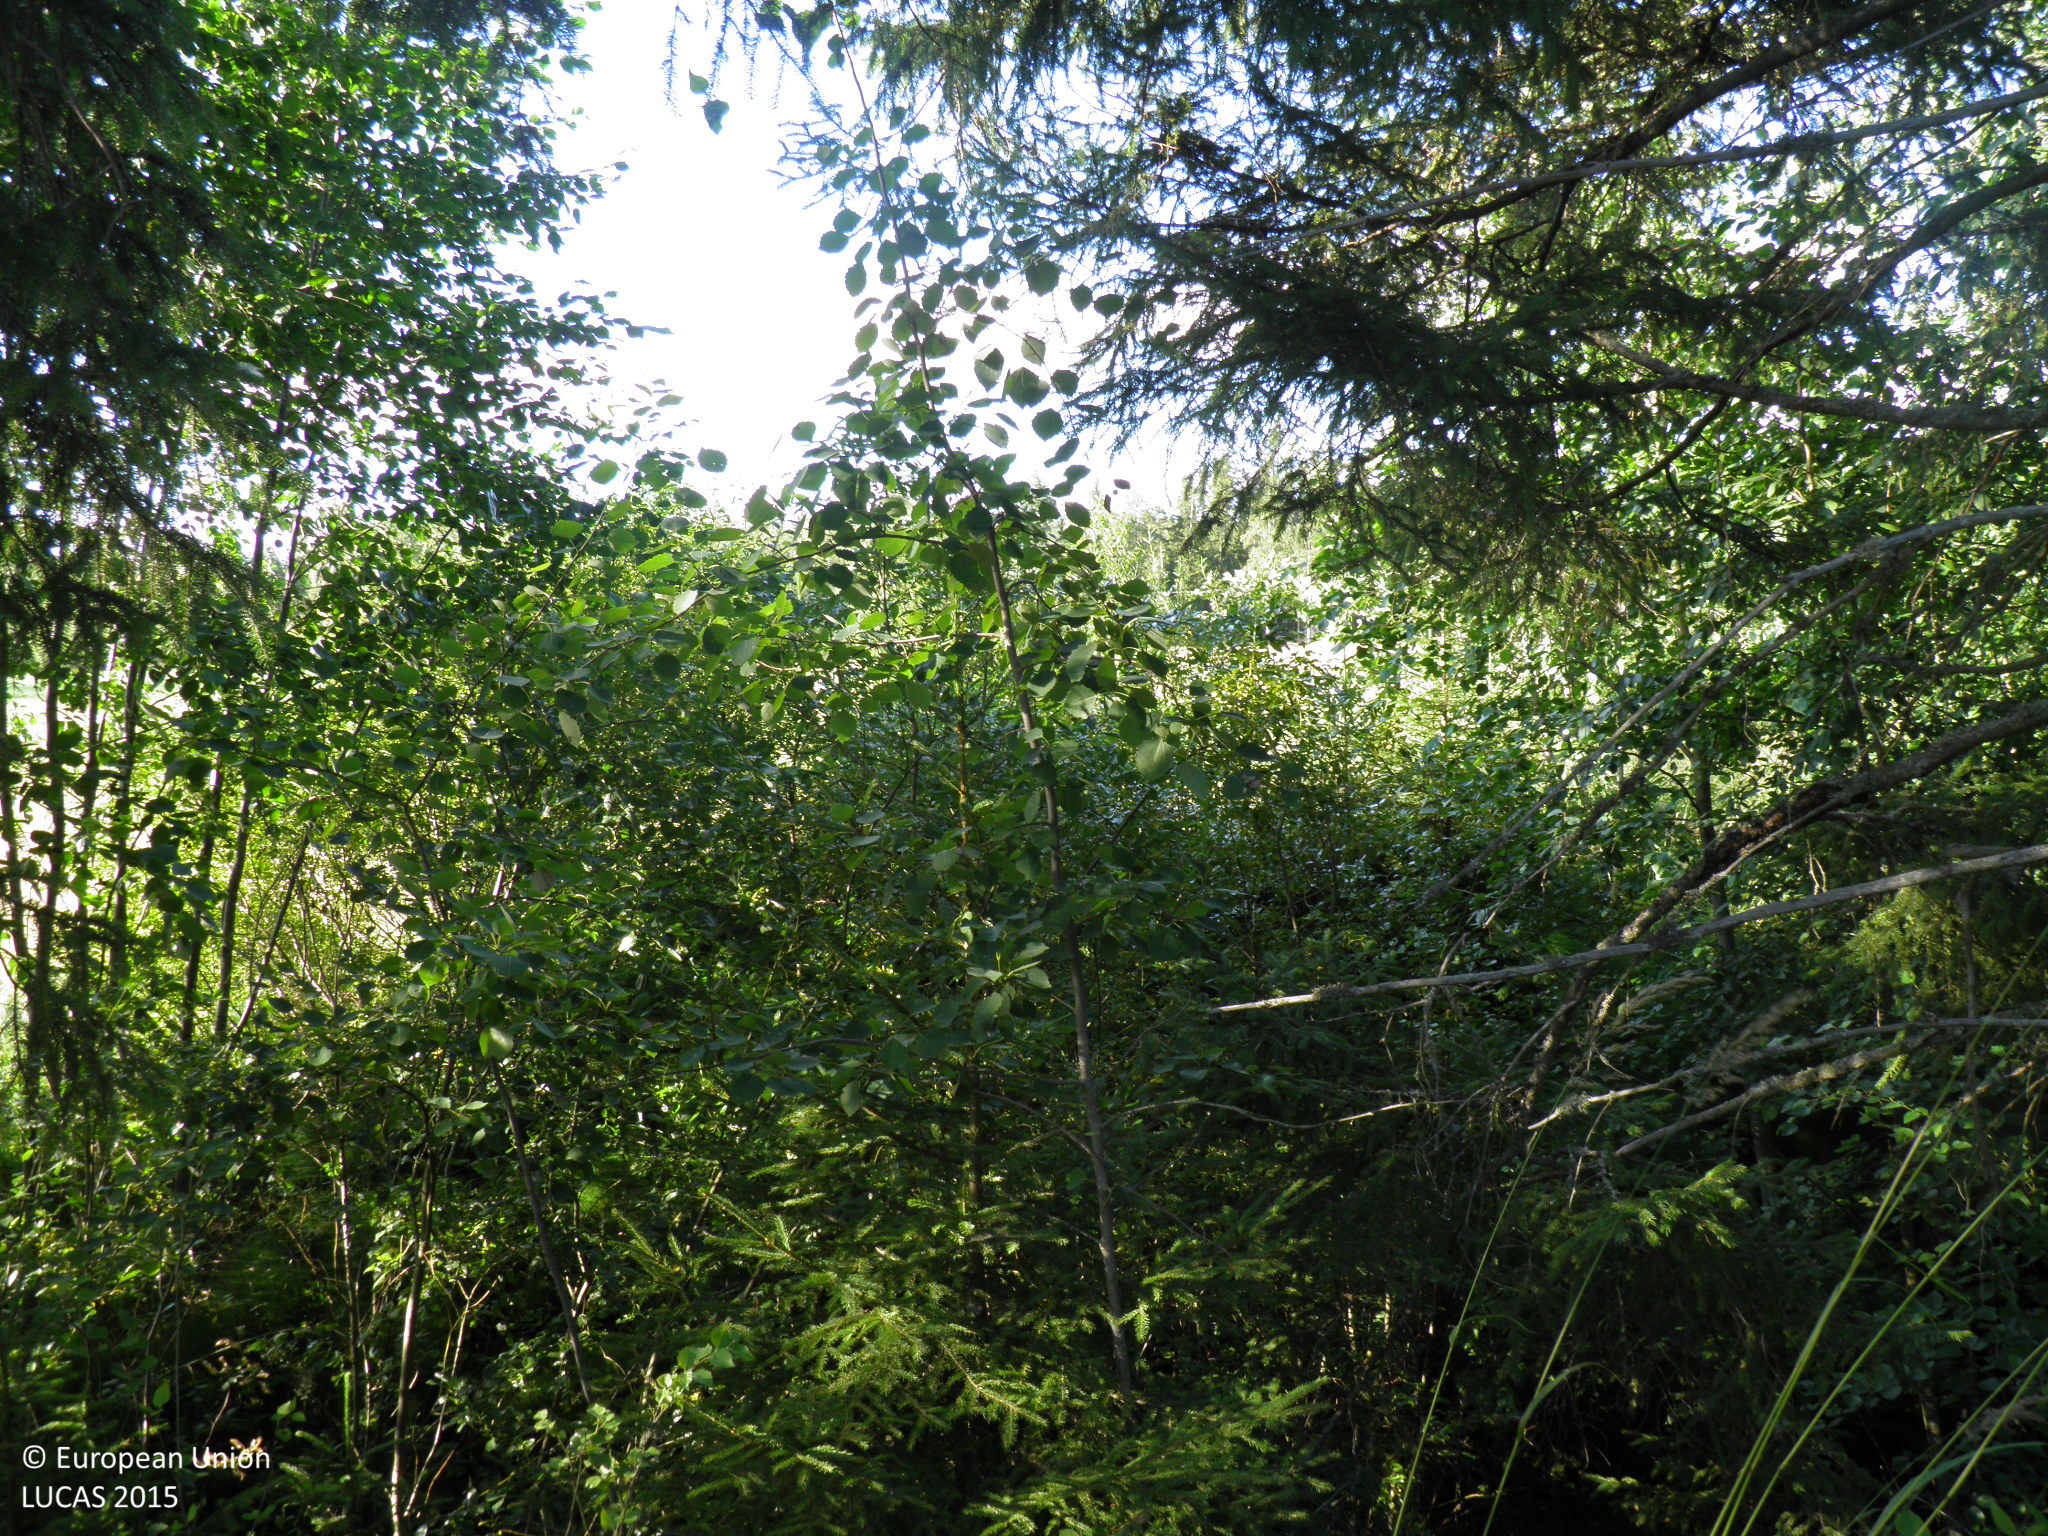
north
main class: Woodland
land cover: Spruce dominated coniferous woodland
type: hemiboreal forest and nemoral coniferous forest and mixed broadleaved-coniferous forest
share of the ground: 25 - 50 %
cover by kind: coniferous forest trees 30 %, herbaceous plants 30 %, shrubs 20 %, broadleaved forest trees 10 %, lichens and mosses 10 %
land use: Forestry
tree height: > 5 m
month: August
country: FI
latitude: 61.0231
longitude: 22.9715
